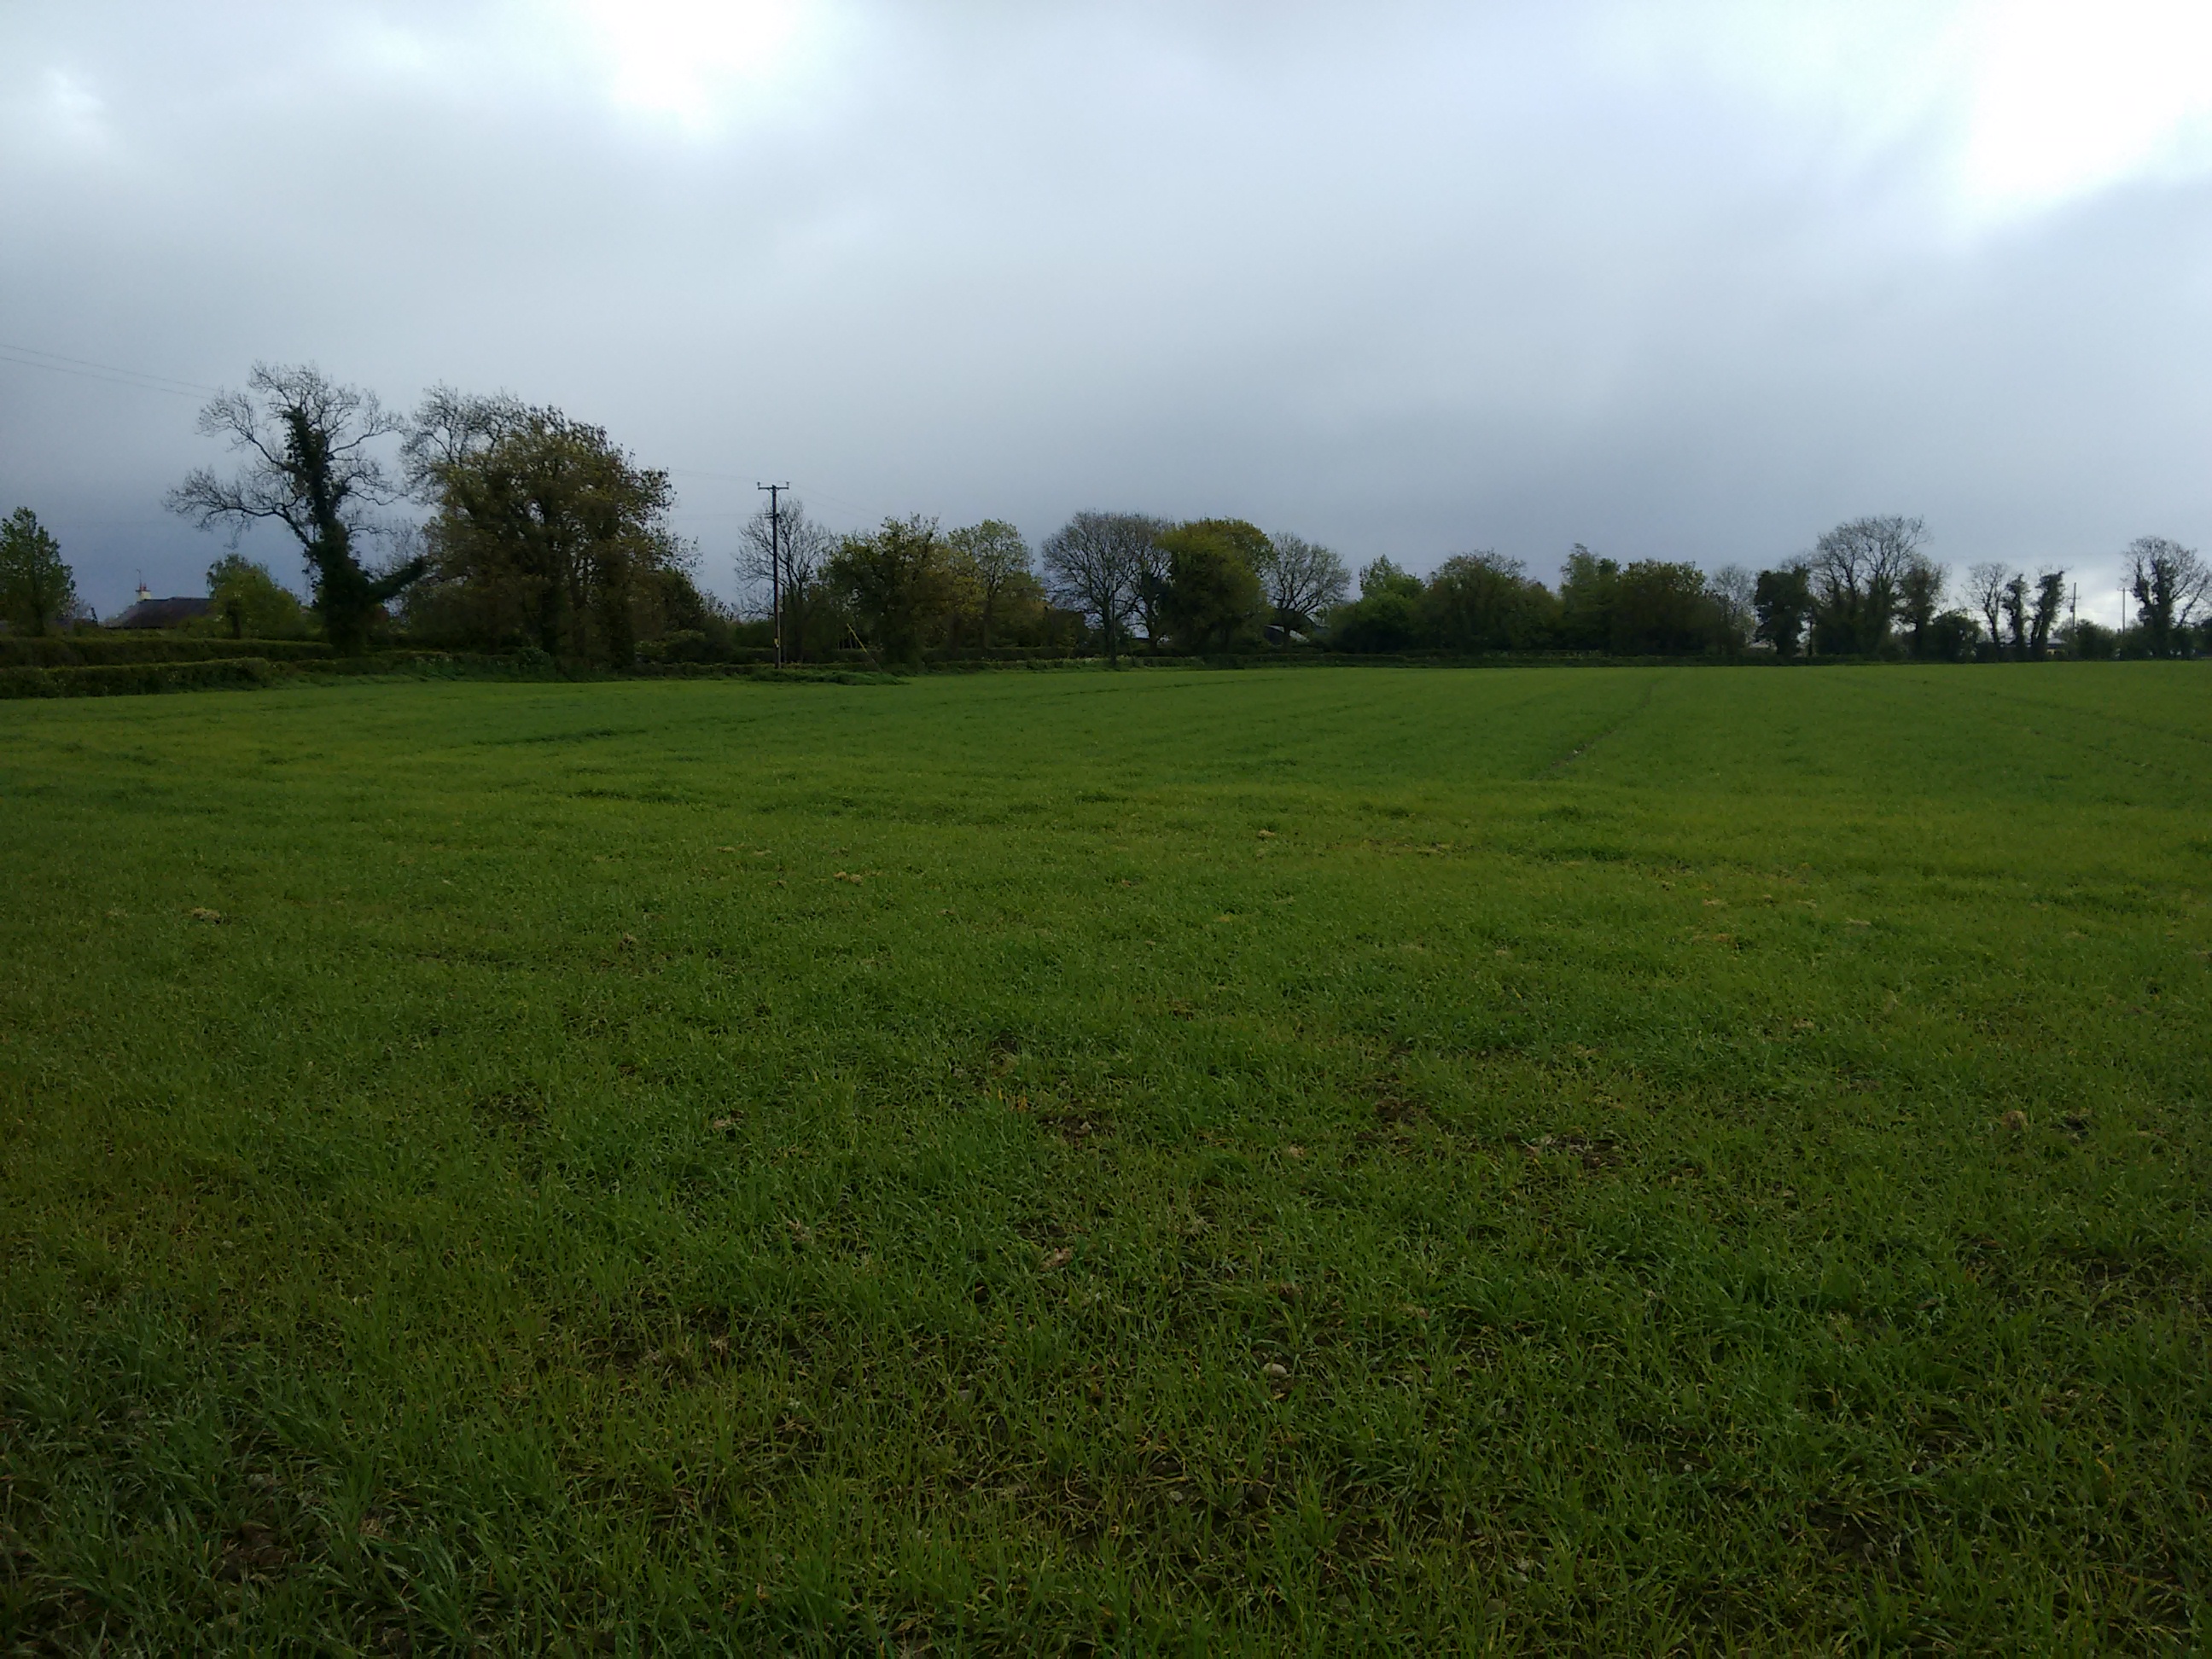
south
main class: Cropland
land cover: Barley
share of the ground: 50 - 75 %
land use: Agriculture (excluding fallow land and kitchen gardens)
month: May
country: IE
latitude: 53.3421
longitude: -6.6376
